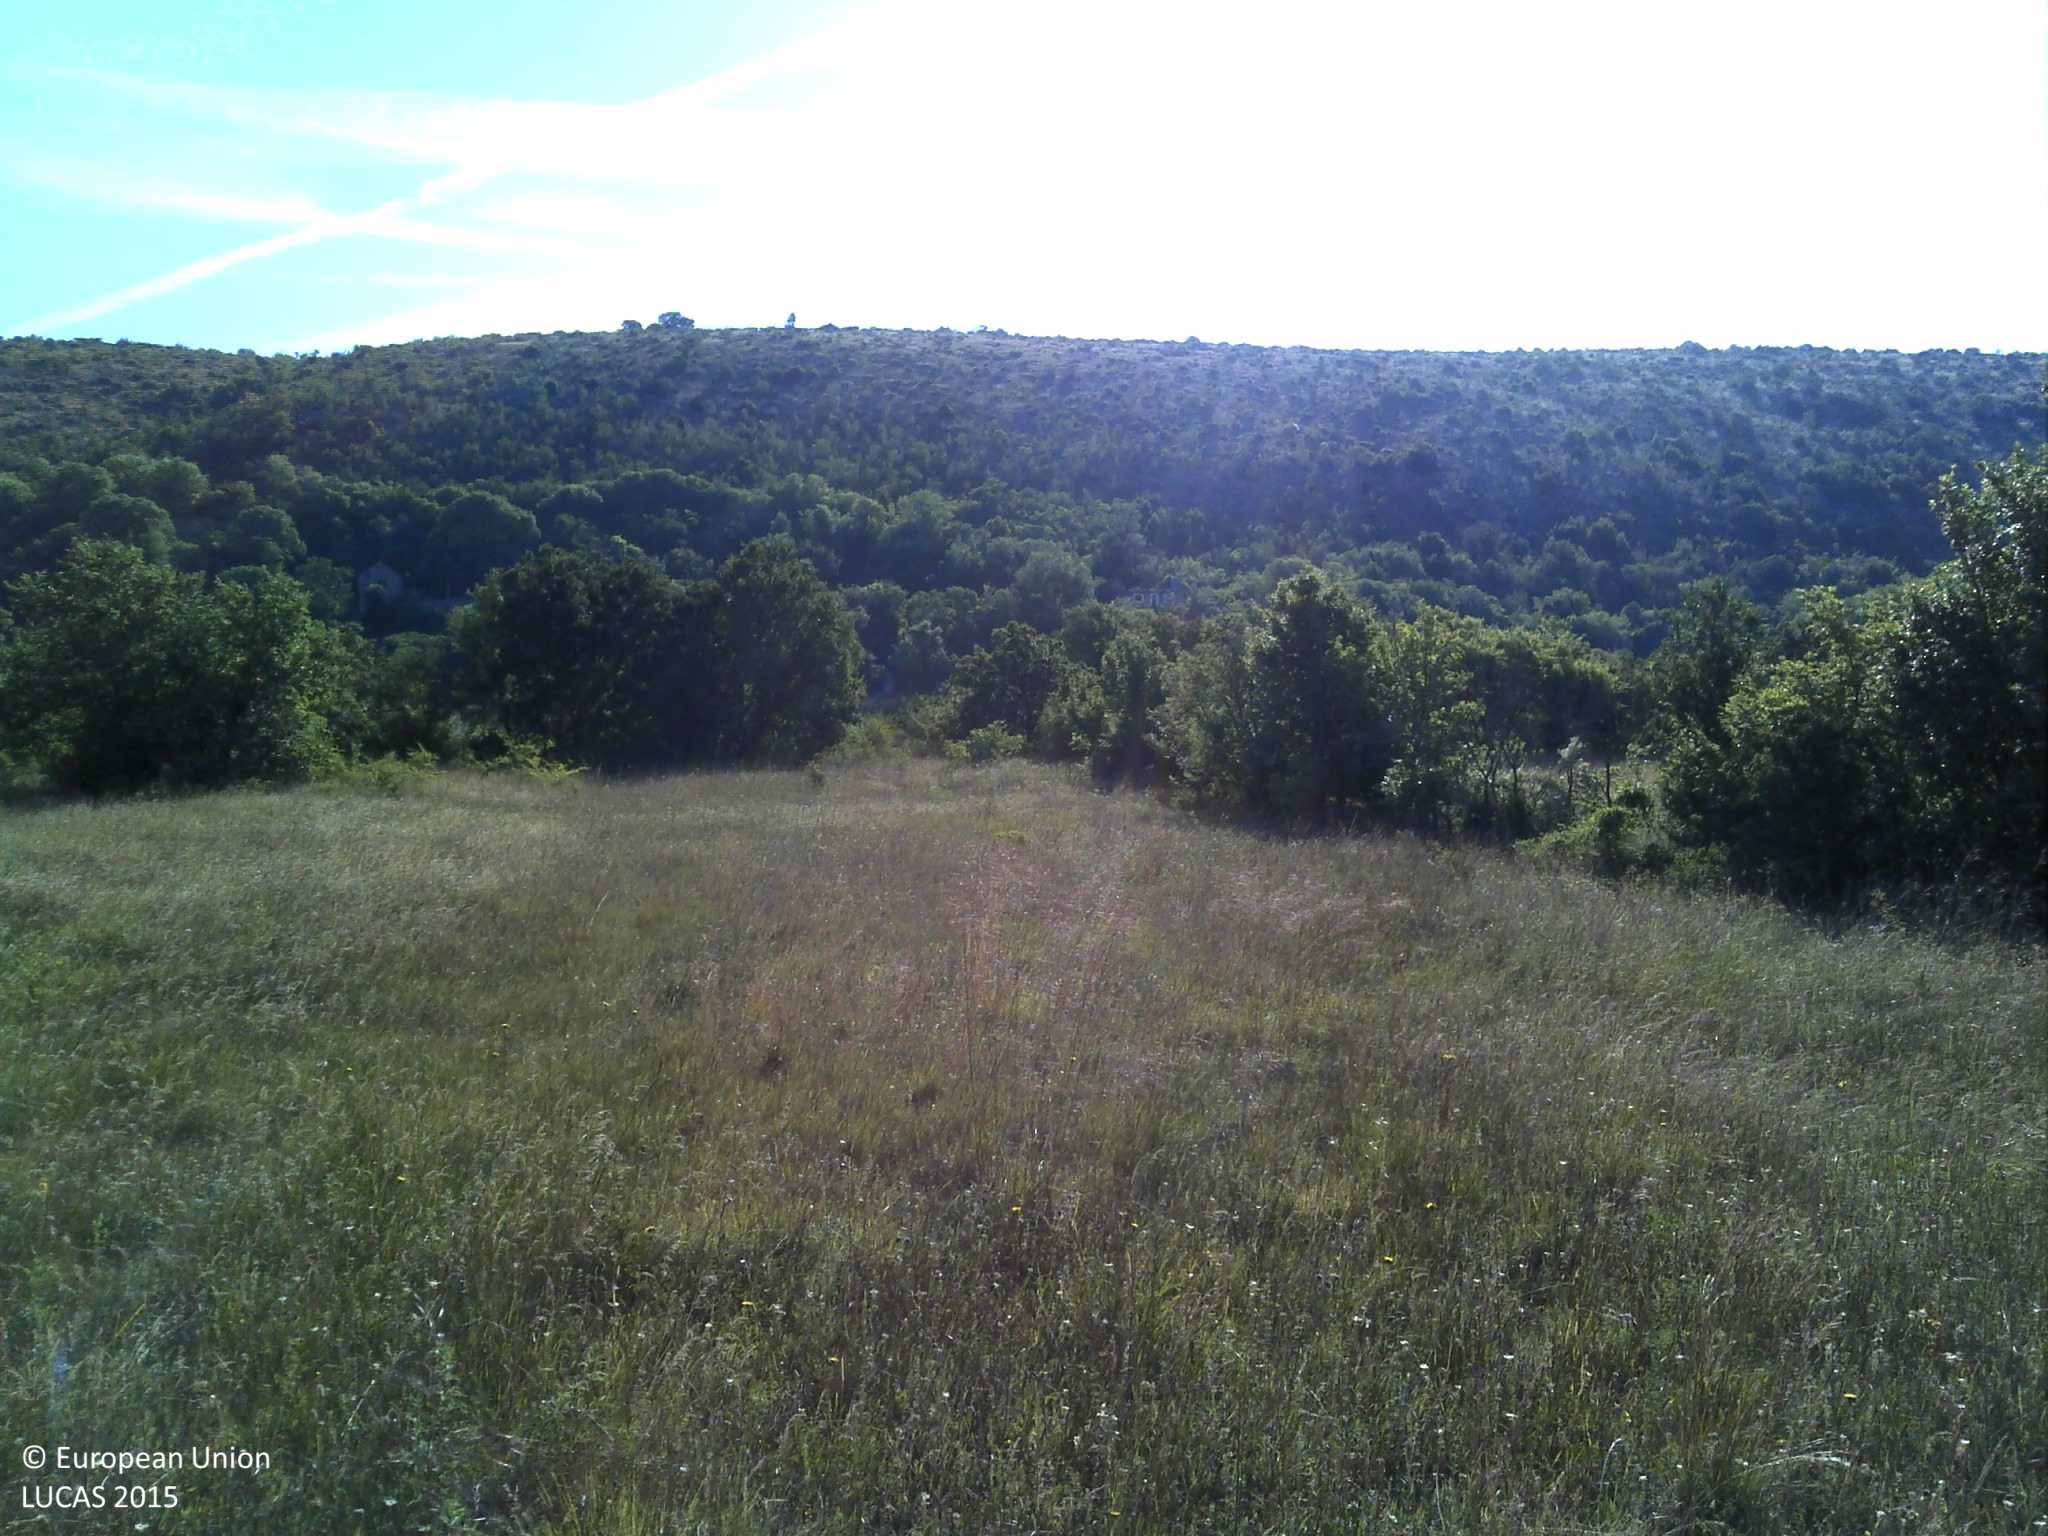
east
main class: Grassland
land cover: Grassland without tree/shrub cover
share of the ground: > 75 %
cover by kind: herbaceous plants 100 %
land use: Agriculture (excluding fallow land and kitchen gardens)
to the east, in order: Grassland without tree/shrub cover; Shrubland with sparse tree cover; Grassland without tree/shrub cover; Shrubland with sparse tree cover; Tracks; Grassland with sparse tree/shrub cover; Electric lines; Shrubland with sparse tree cover; Grassland without tree/shrub cover; Shrubland with sparse tree cover; Grassland with sparse tree/shrub cover
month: July
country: HR
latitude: 43.8546
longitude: 16.2495
